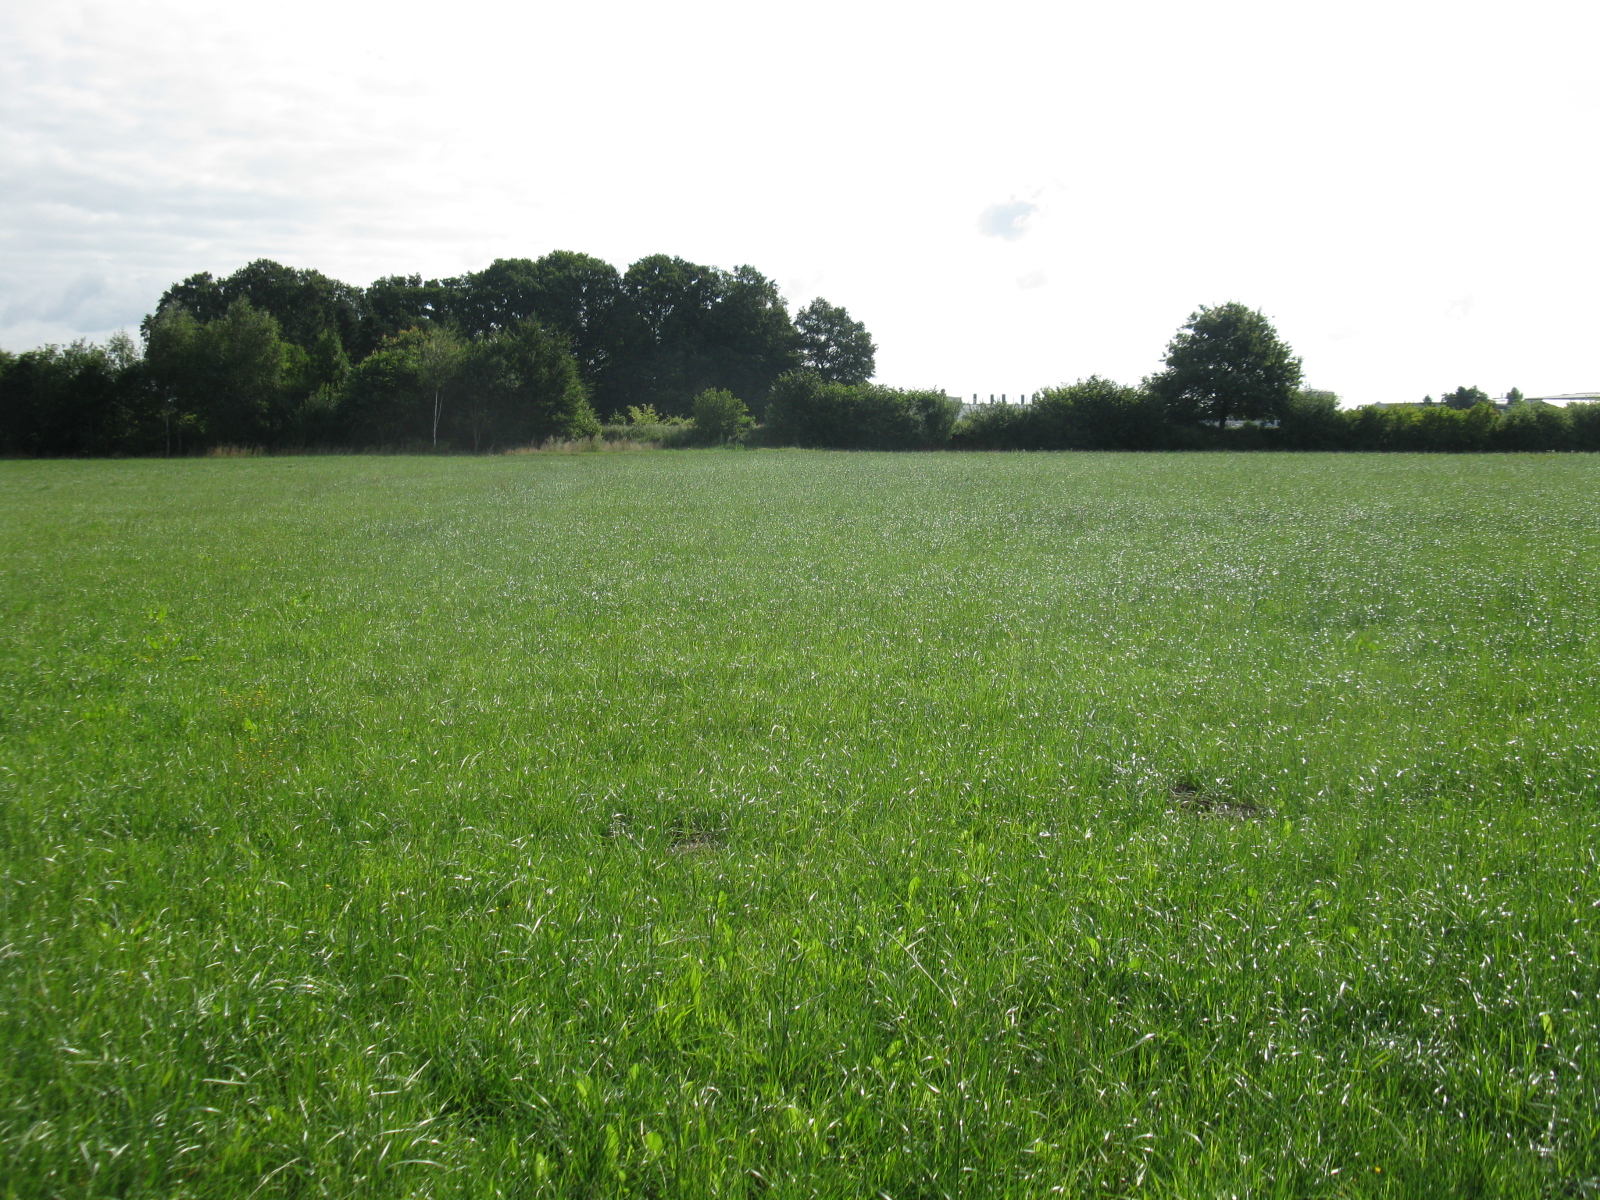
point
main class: Grassland
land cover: Grassland without tree/shrub cover
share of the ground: > 75 %
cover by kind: herbaceous plants 100 %
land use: Agriculture (excluding fallow land and kitchen gardens)
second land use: Commerce
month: July
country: DE
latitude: 53.0334
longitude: 8.5242
